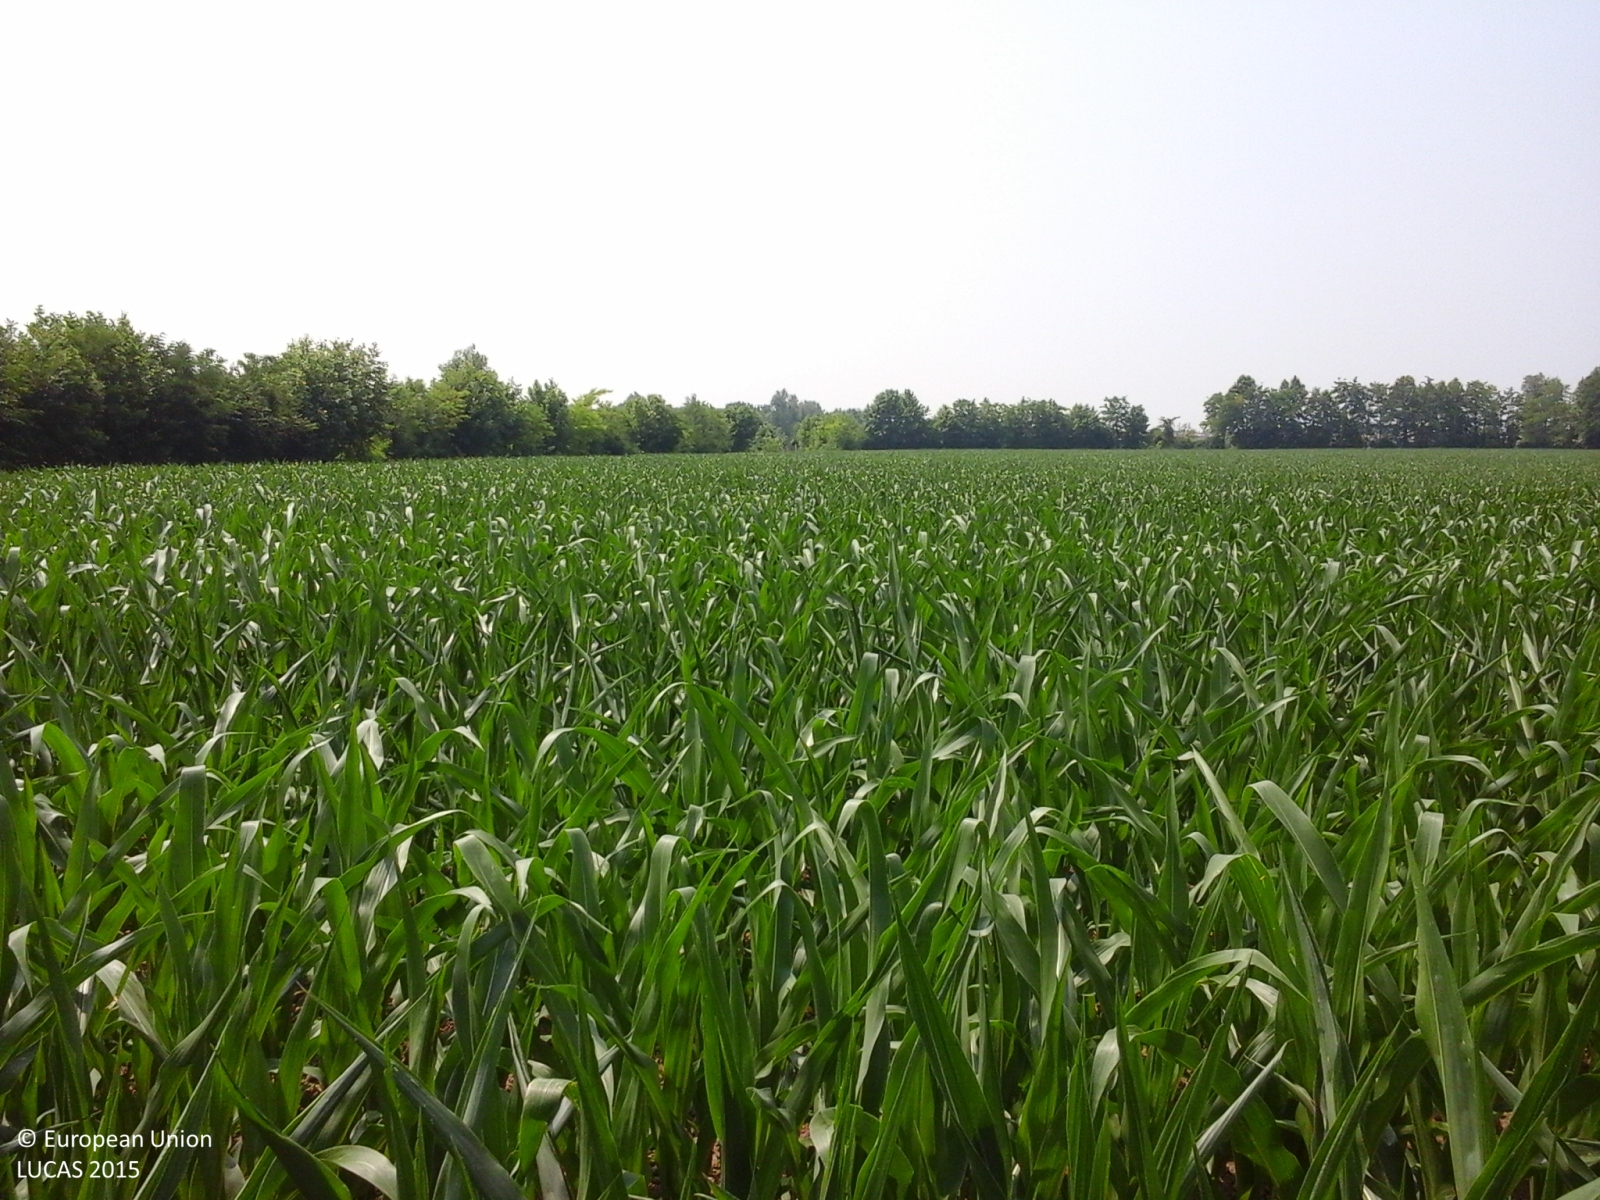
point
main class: Cropland
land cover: Maize
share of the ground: > 75 %
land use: Agriculture (excluding fallow land and kitchen gardens)
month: June
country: IT
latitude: 45.4682
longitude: 10.1915
